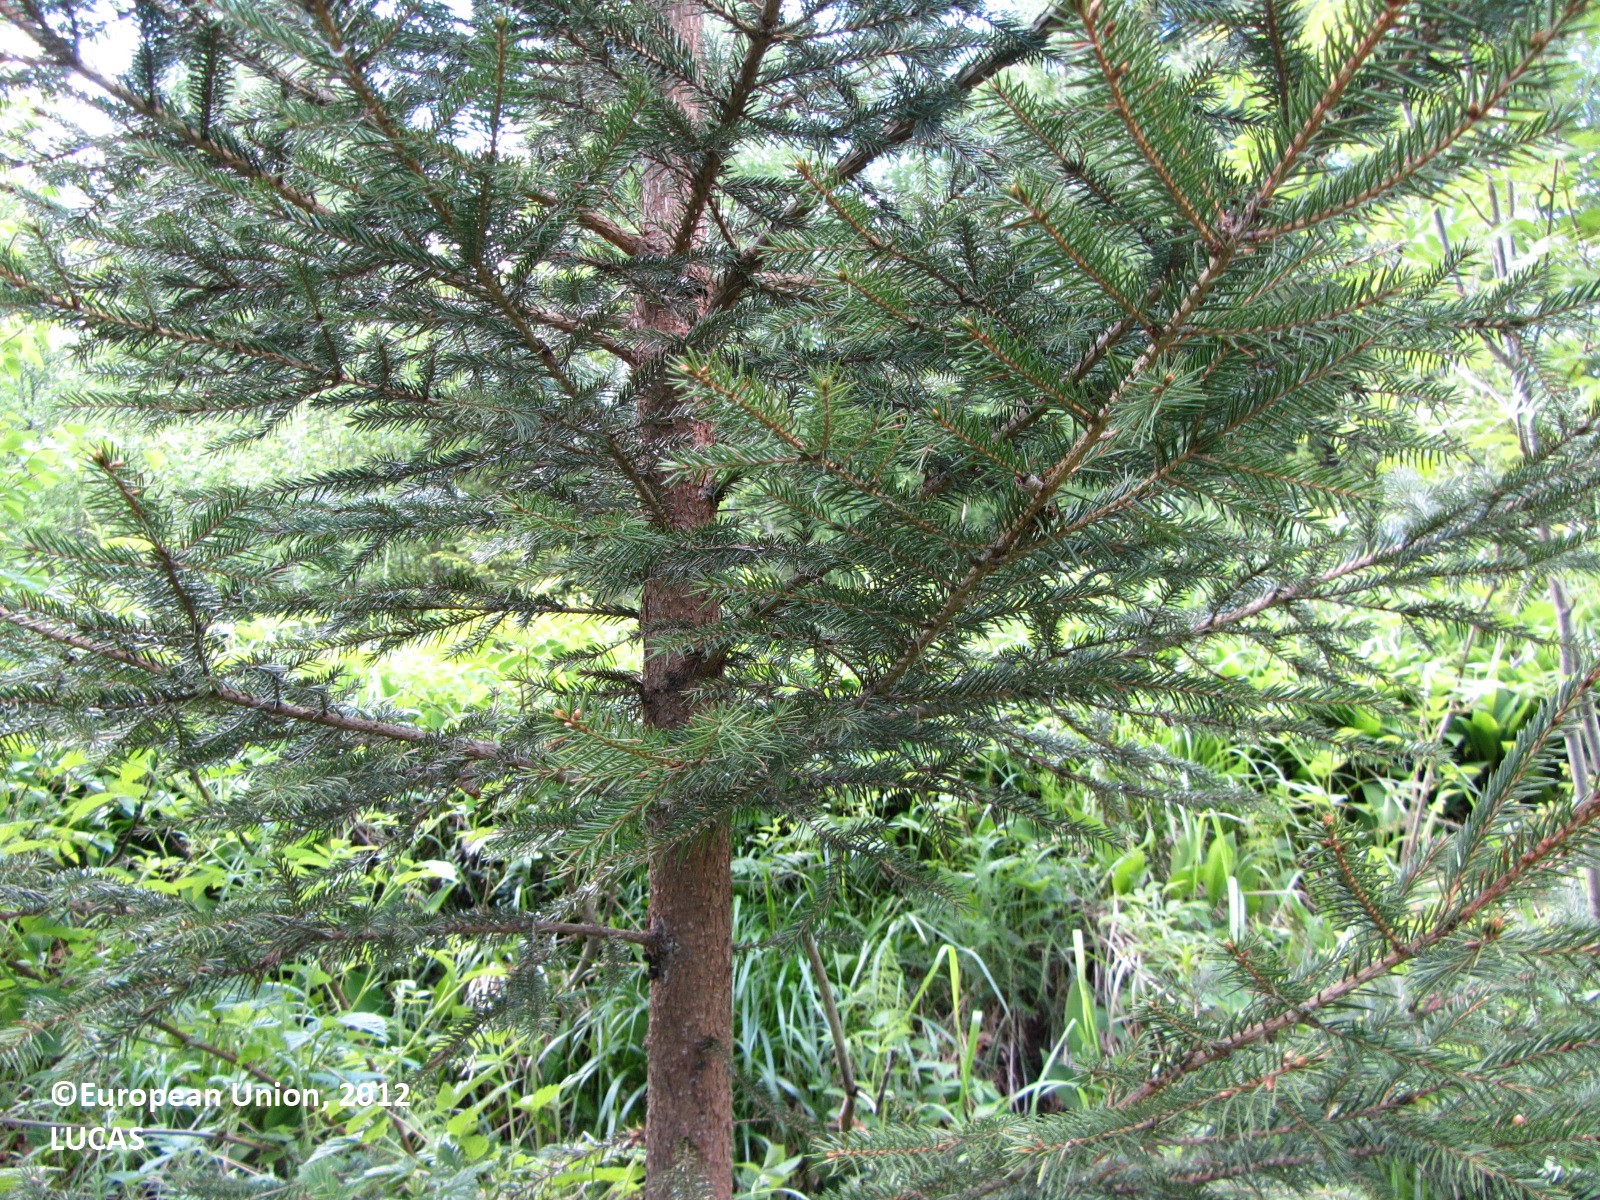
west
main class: Woodland
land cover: Spruce dominated mixed woodland
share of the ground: > 75 %
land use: Forestry
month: June
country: FI
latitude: 61.8057
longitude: 25.1171
